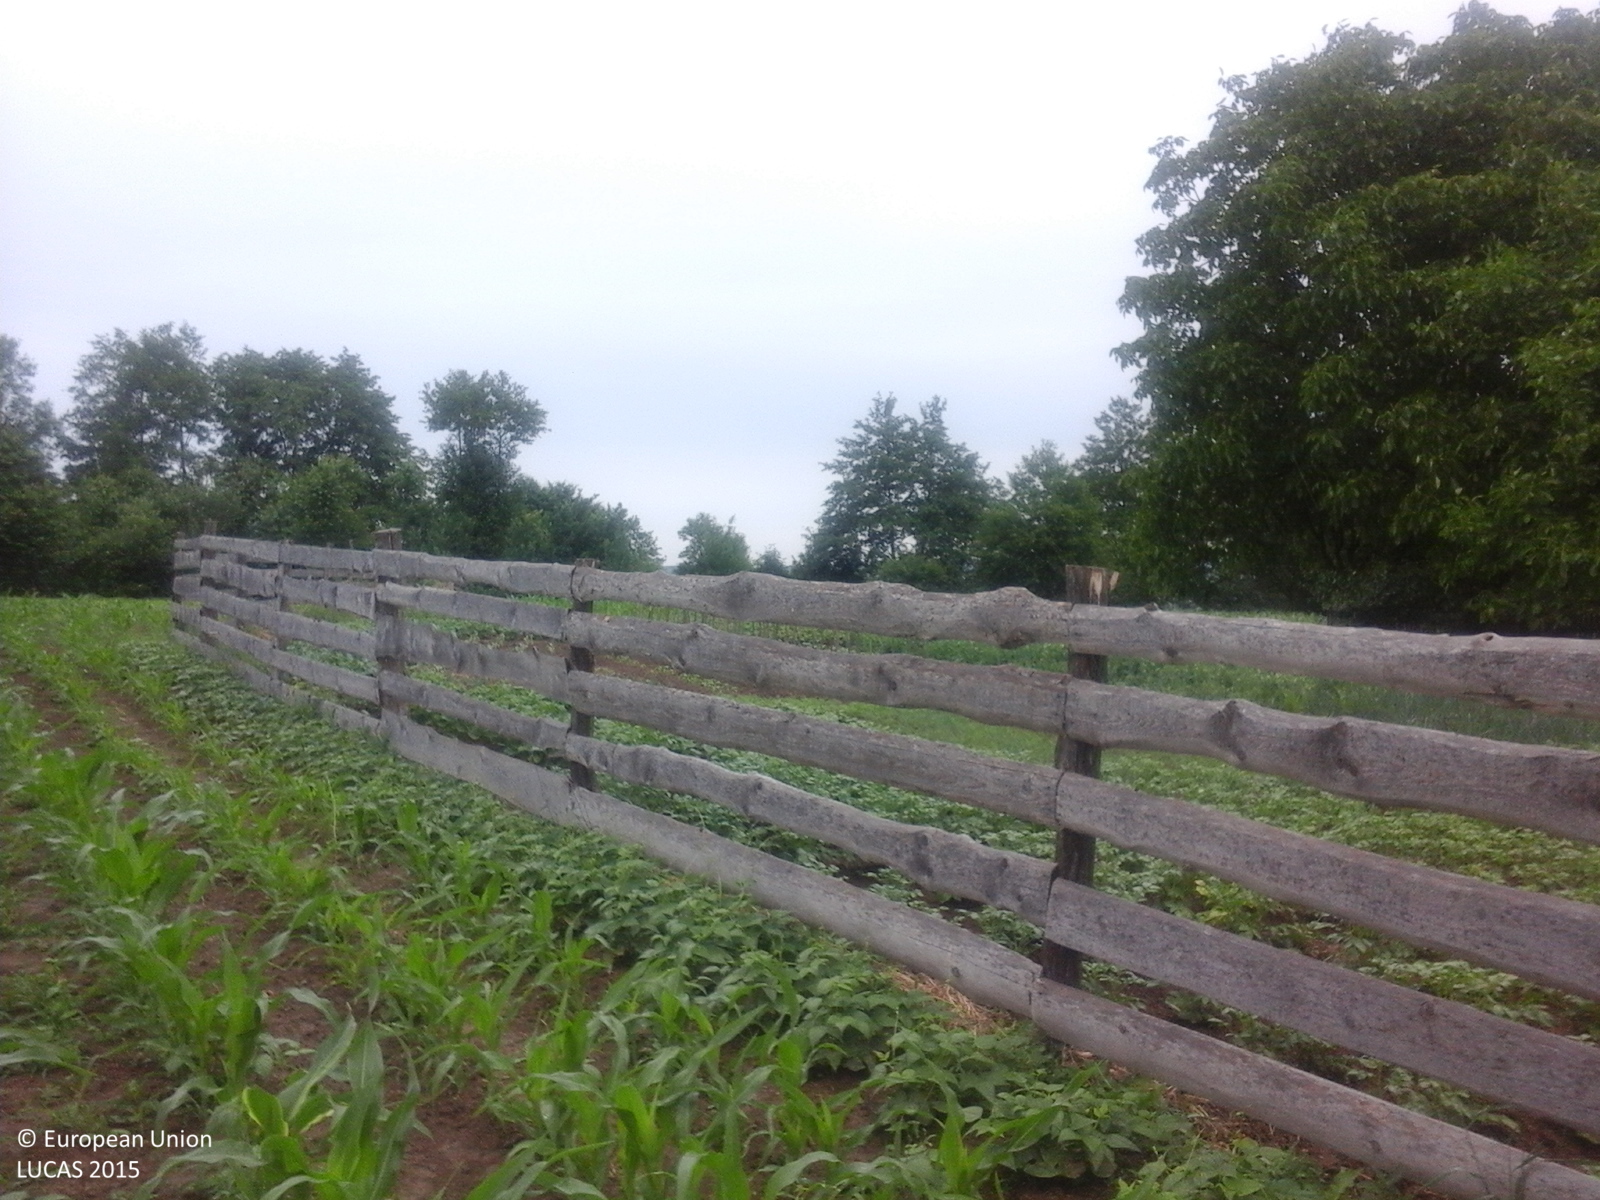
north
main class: Cropland
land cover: Maize
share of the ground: 25 - 50 %
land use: Agriculture (excluding fallow land and kitchen gardens)
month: June
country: RO
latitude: 47.8949
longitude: 25.7064
